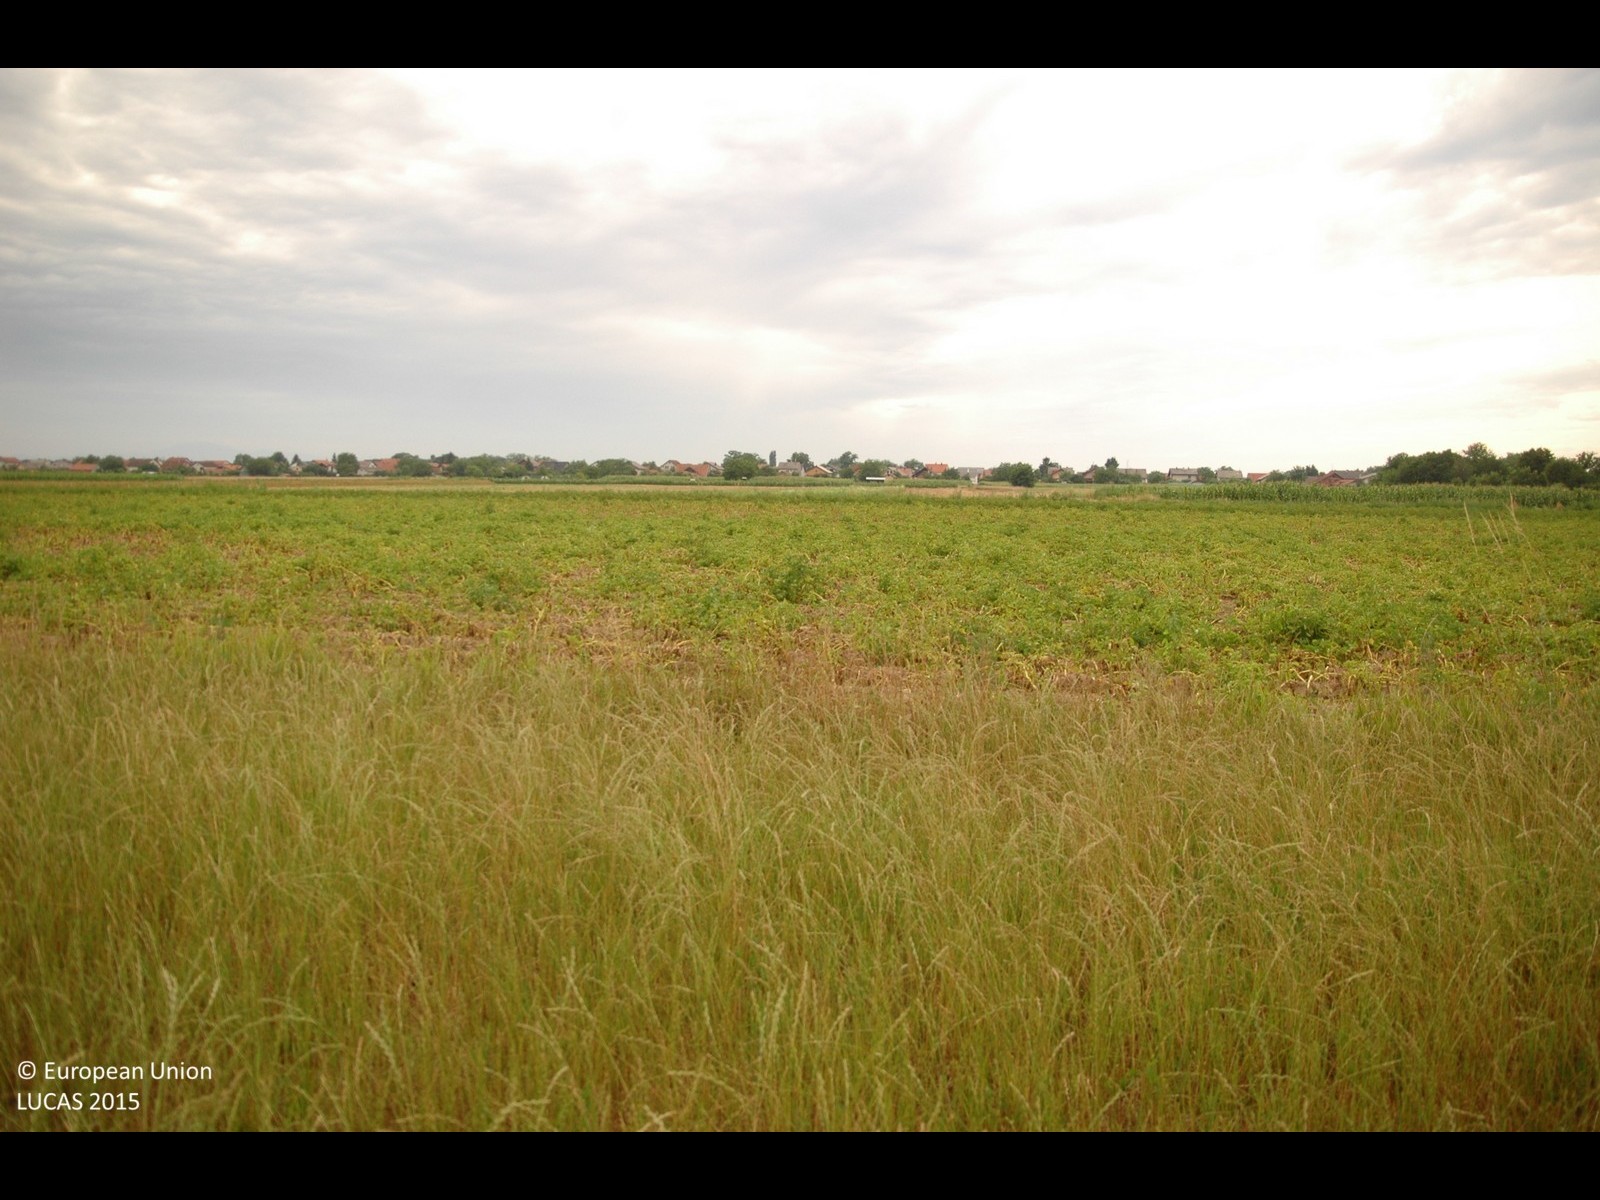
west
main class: Grassland
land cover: Grassland without tree/shrub cover
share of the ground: > 75 %
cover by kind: herbaceous plants 100 %
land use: Agriculture (excluding fallow land and kitchen gardens)
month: July
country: HR
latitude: 46.3741
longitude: 16.4357
